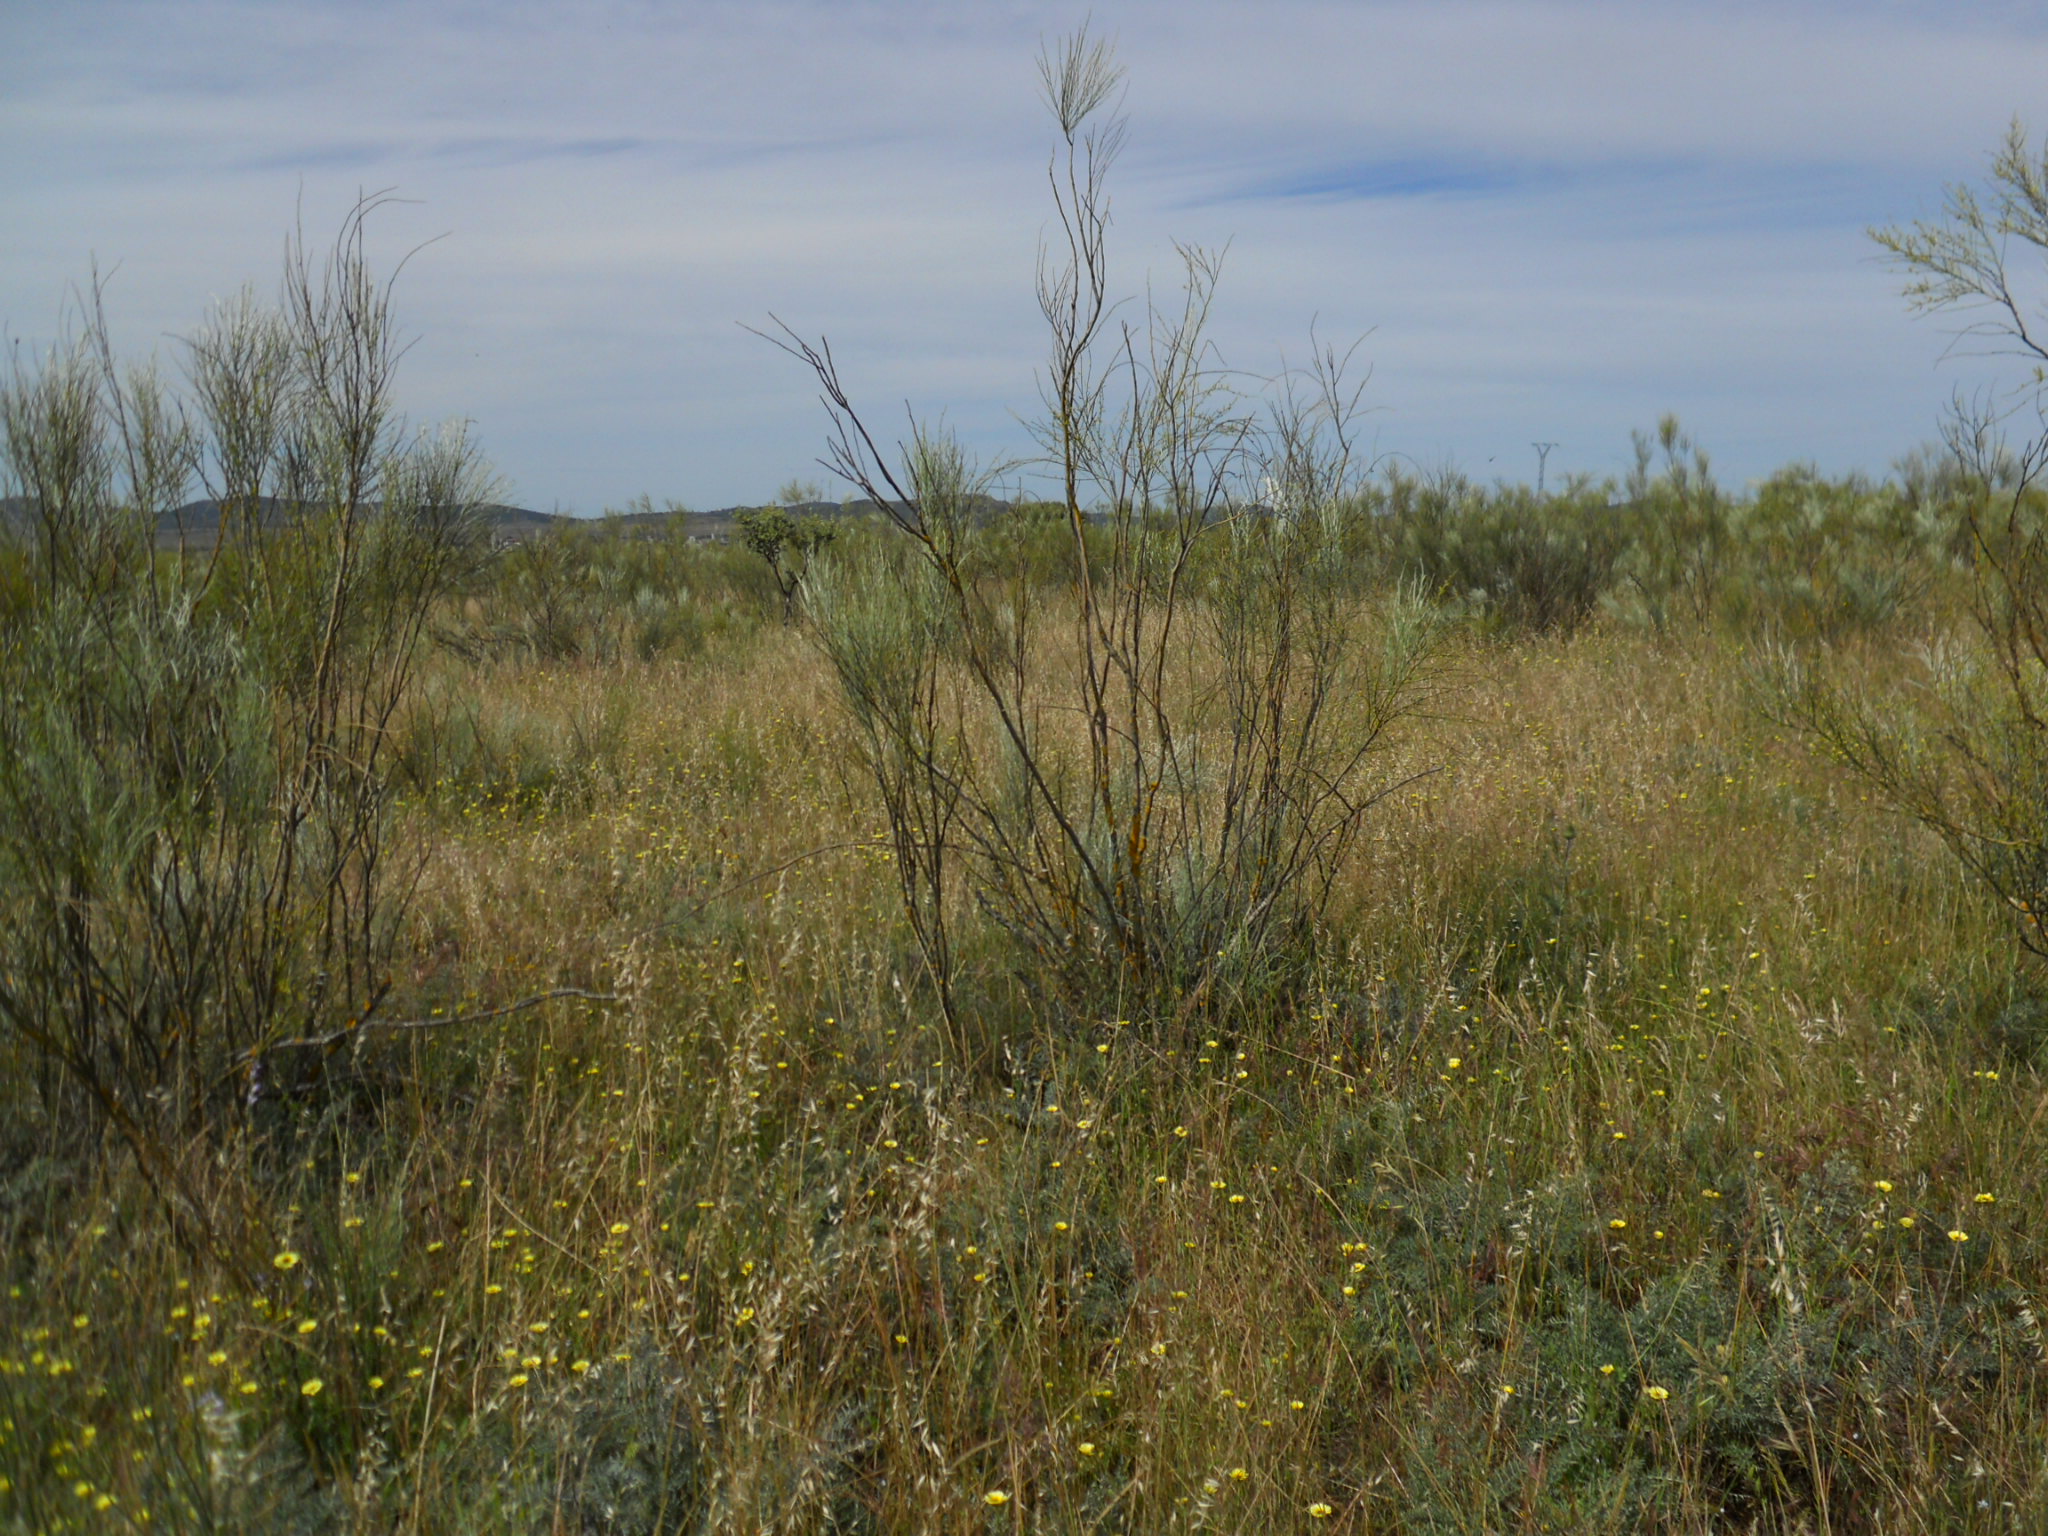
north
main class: Shrubland
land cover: Shrubland with sparse tree cover
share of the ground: 50 - 75 %
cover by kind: shrubs 80 %, herbaceous plants 15 %, broadleaved forest trees 5 %
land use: Agriculture (excluding fallow land and kitchen gardens)
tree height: < 5 m
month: May
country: ES
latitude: 39.3466
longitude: -6.3449
